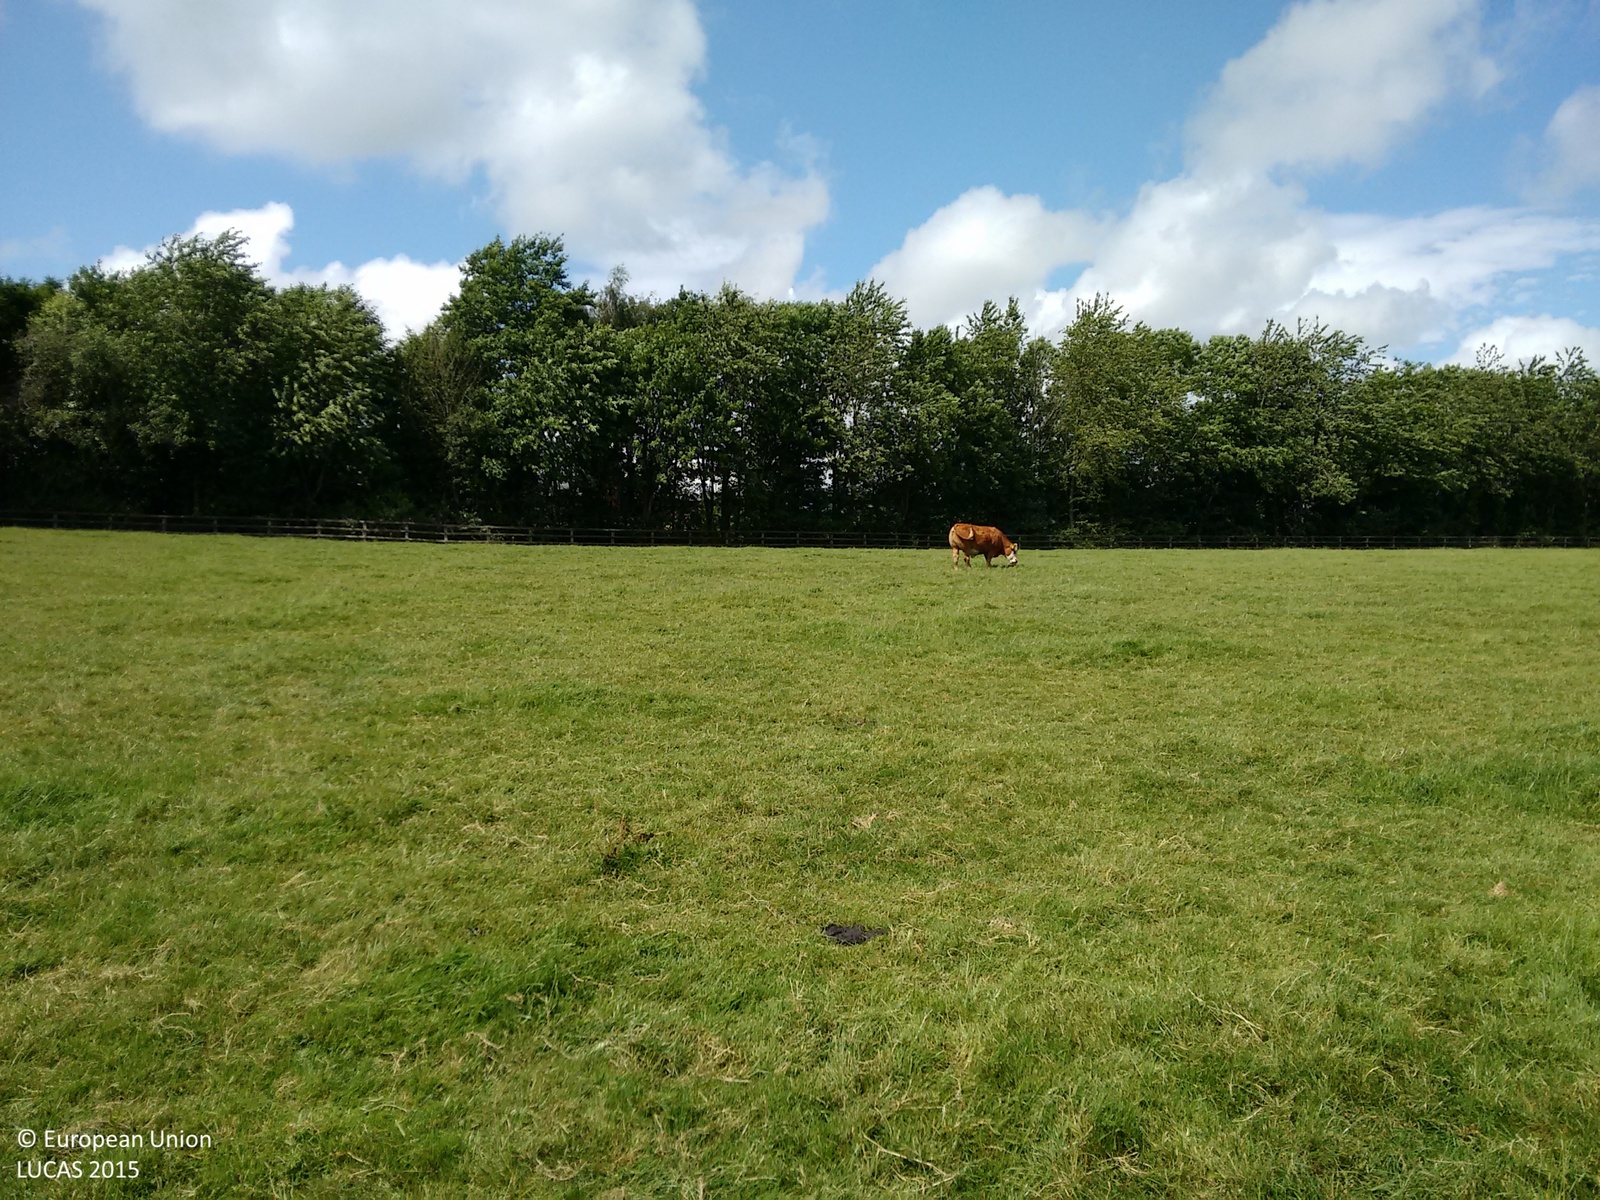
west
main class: Grassland
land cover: Grassland without tree/shrub cover
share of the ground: > 75 %
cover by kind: herbaceous plants 100 %
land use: Agriculture (excluding fallow land and kitchen gardens)
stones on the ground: < 10 %
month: July
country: IE
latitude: 52.4915
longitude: -7.6764
